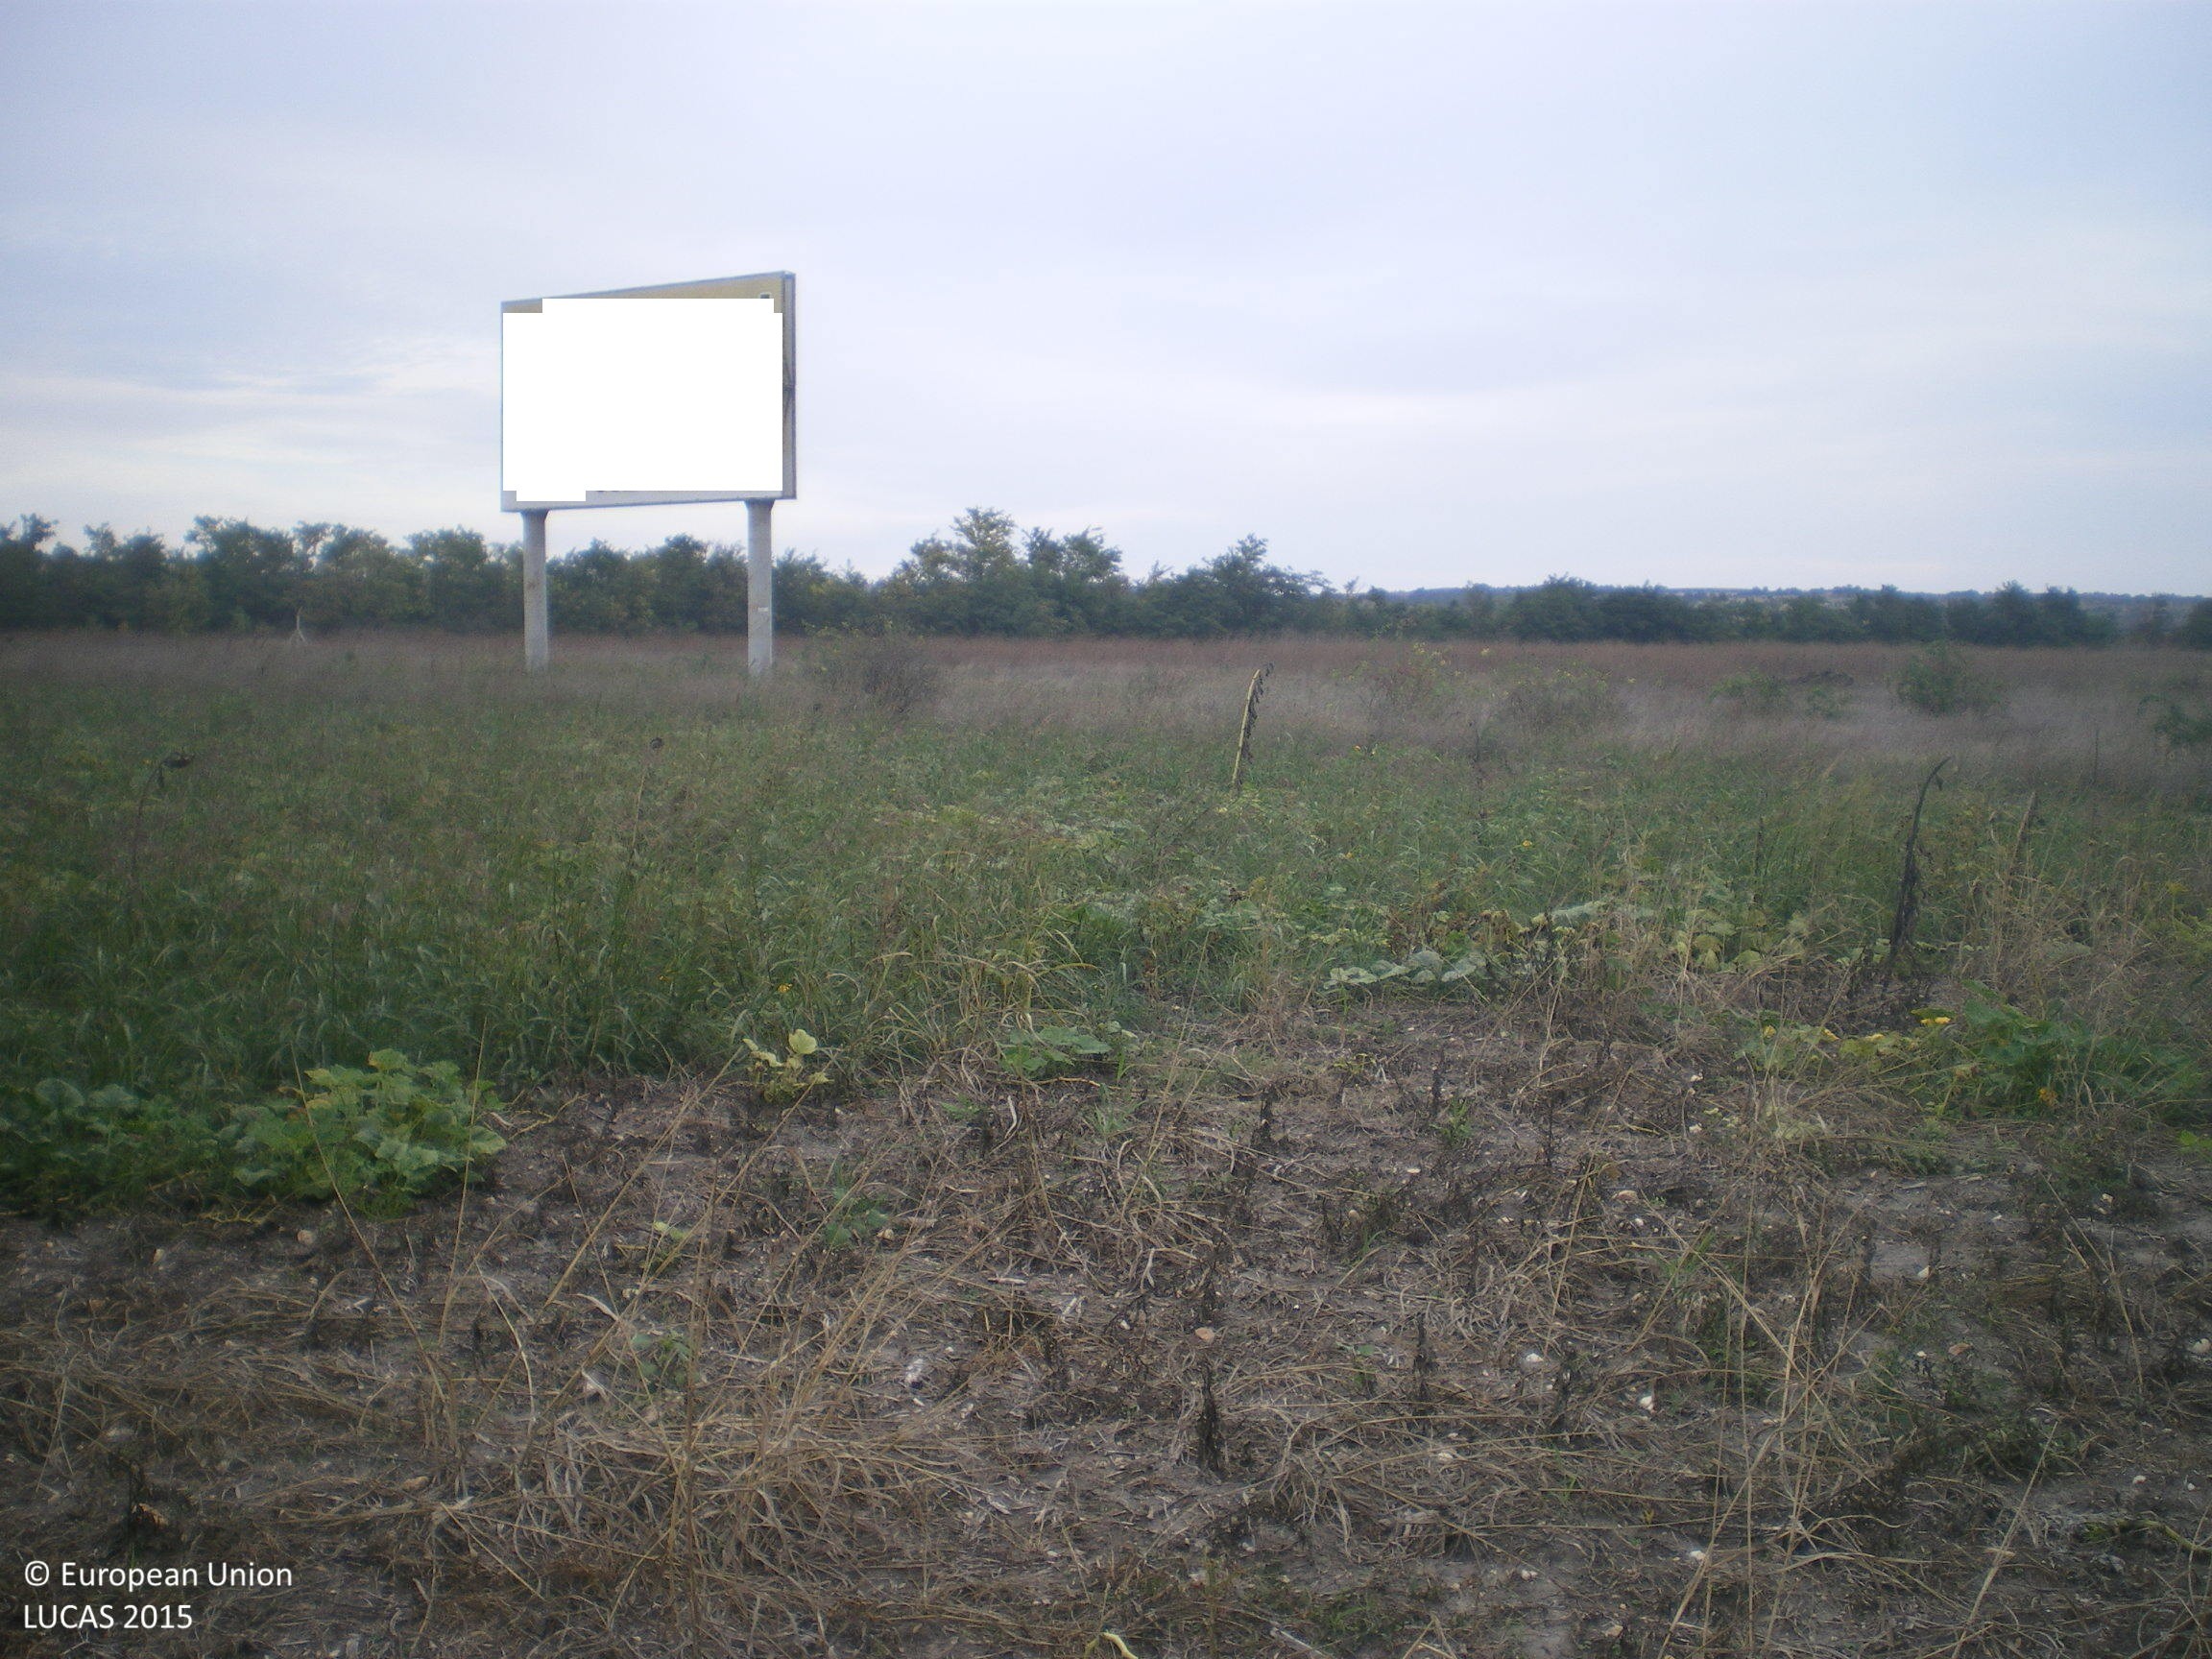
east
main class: Cropland
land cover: Other fresh vegetables
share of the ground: 10 - 25 %
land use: Agriculture (excluding fallow land and kitchen gardens)
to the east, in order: Other fresh vegetables; Spontaneously vegetated surfaces; Grassland without tree/shrub cover; Shruby margins; Grassland without tree/shrub cover; Tracks; Grassland without tree/shrub cover; Broadleaved woodland; Ditches and canals; Broadleaved woodland; Grass margins; Tracks; Sunflower
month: October
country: BG
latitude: 41.8261
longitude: 26.1489
